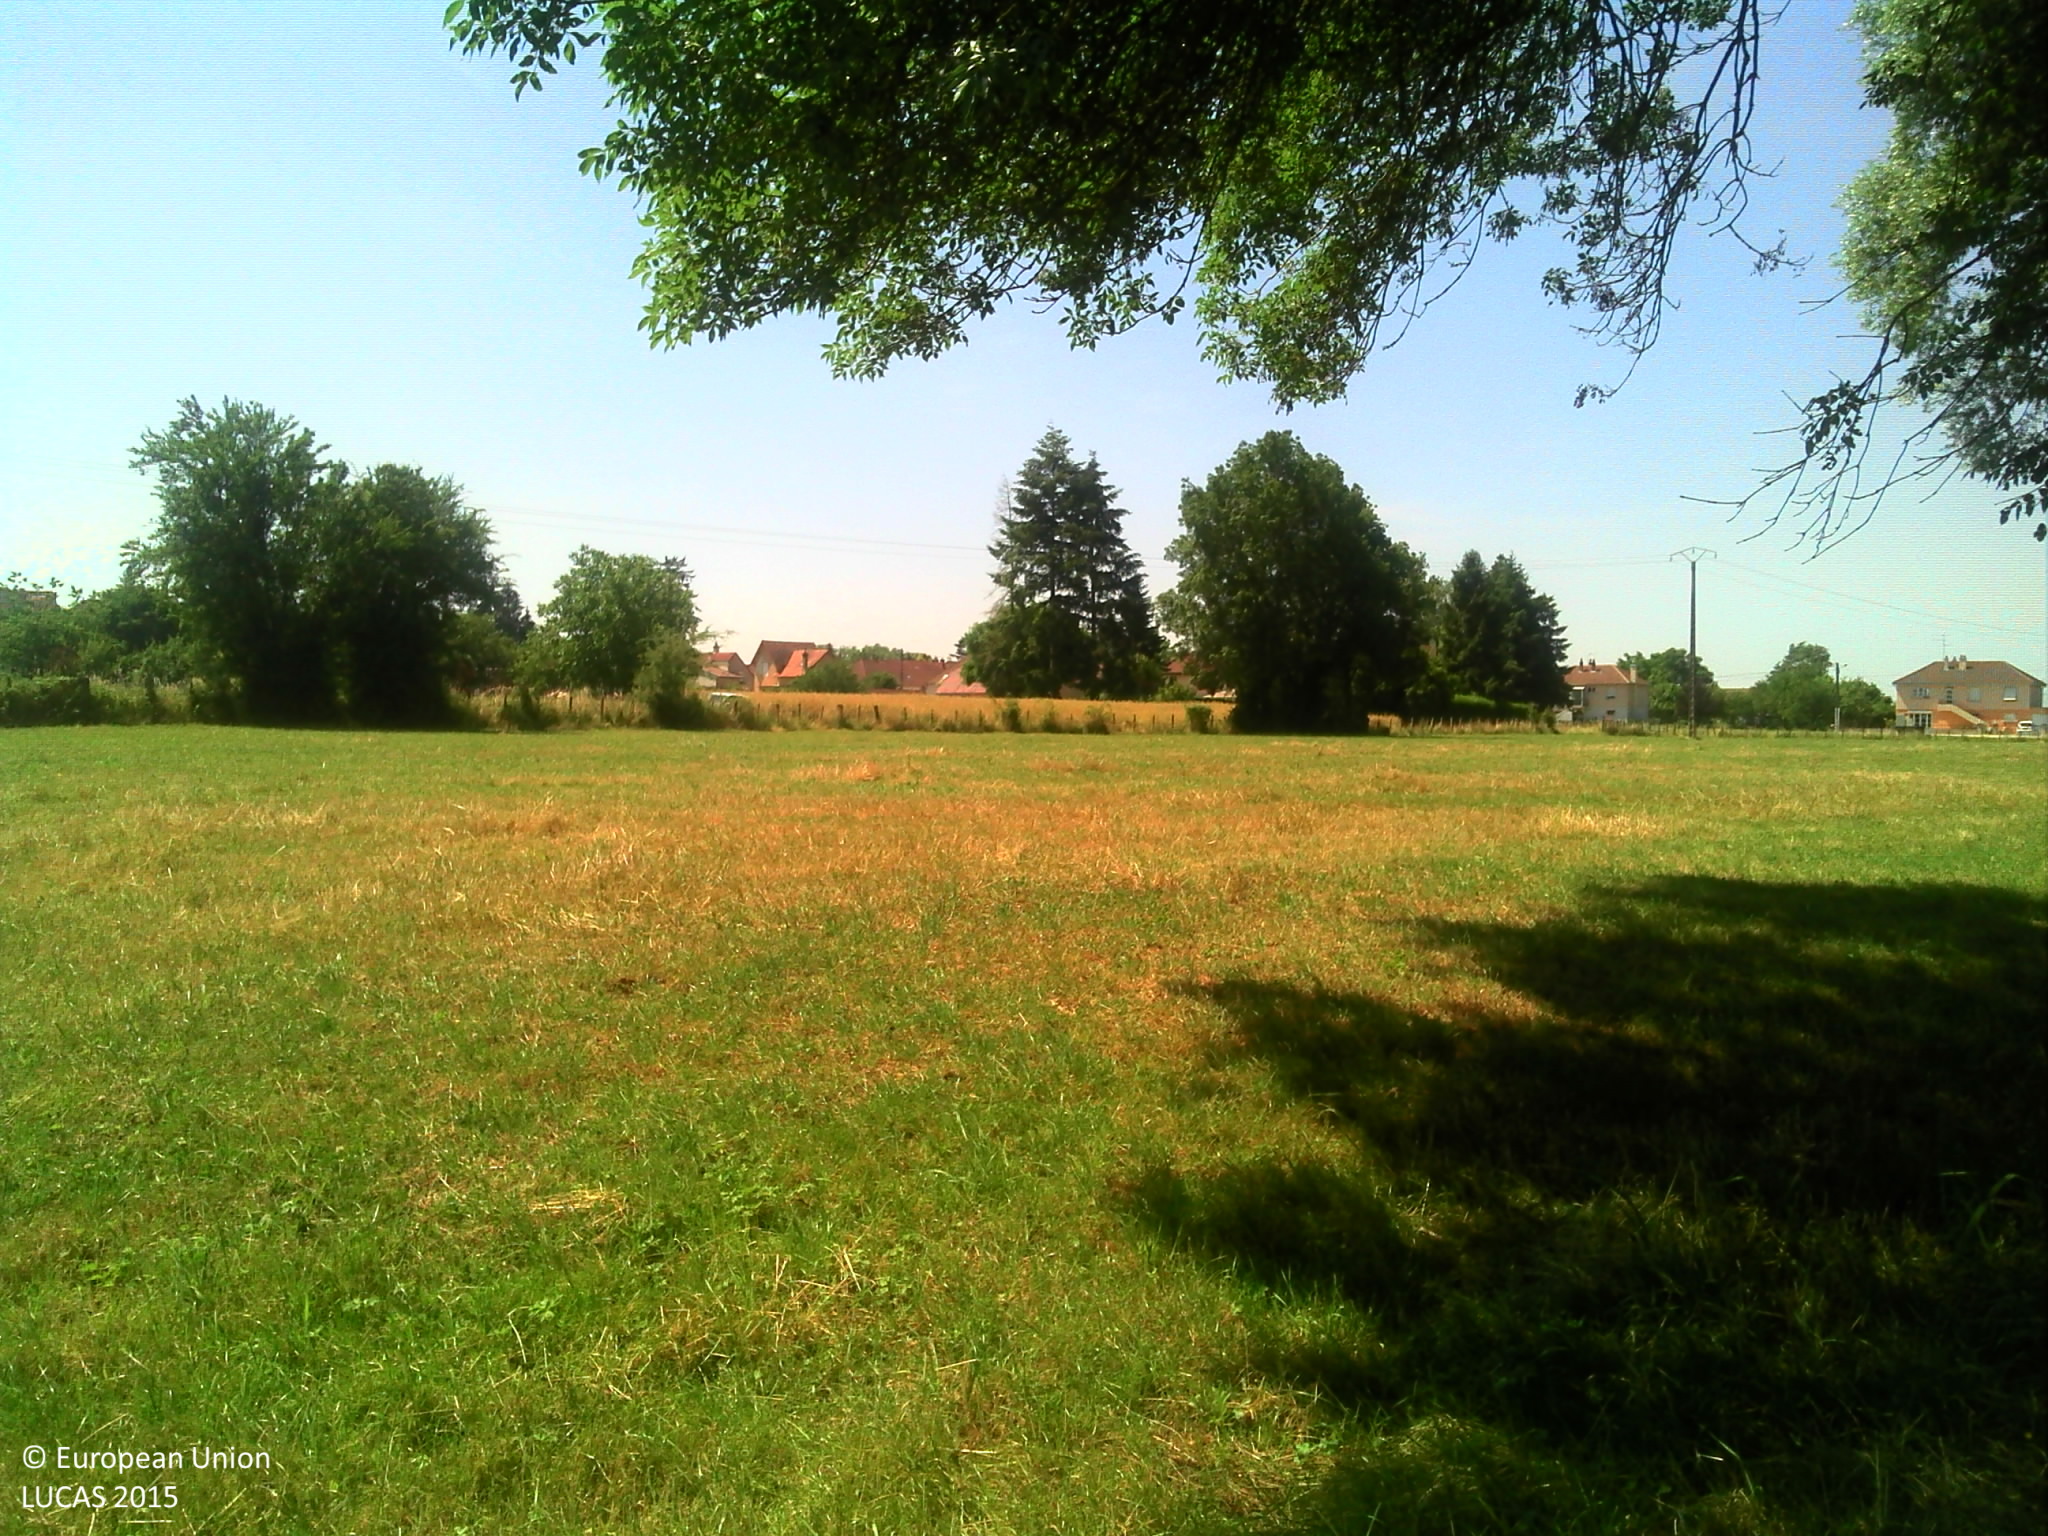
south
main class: Grassland
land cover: Grassland with sparse tree/shrub cover
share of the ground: > 75 %
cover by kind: herbaceous plants 90 %, broadleaved forest trees 5 %, shrubs 5 %
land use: Agriculture (excluding fallow land and kitchen gardens)
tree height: > 5 m
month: June
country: FR
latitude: 47.0945
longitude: 5.2717
